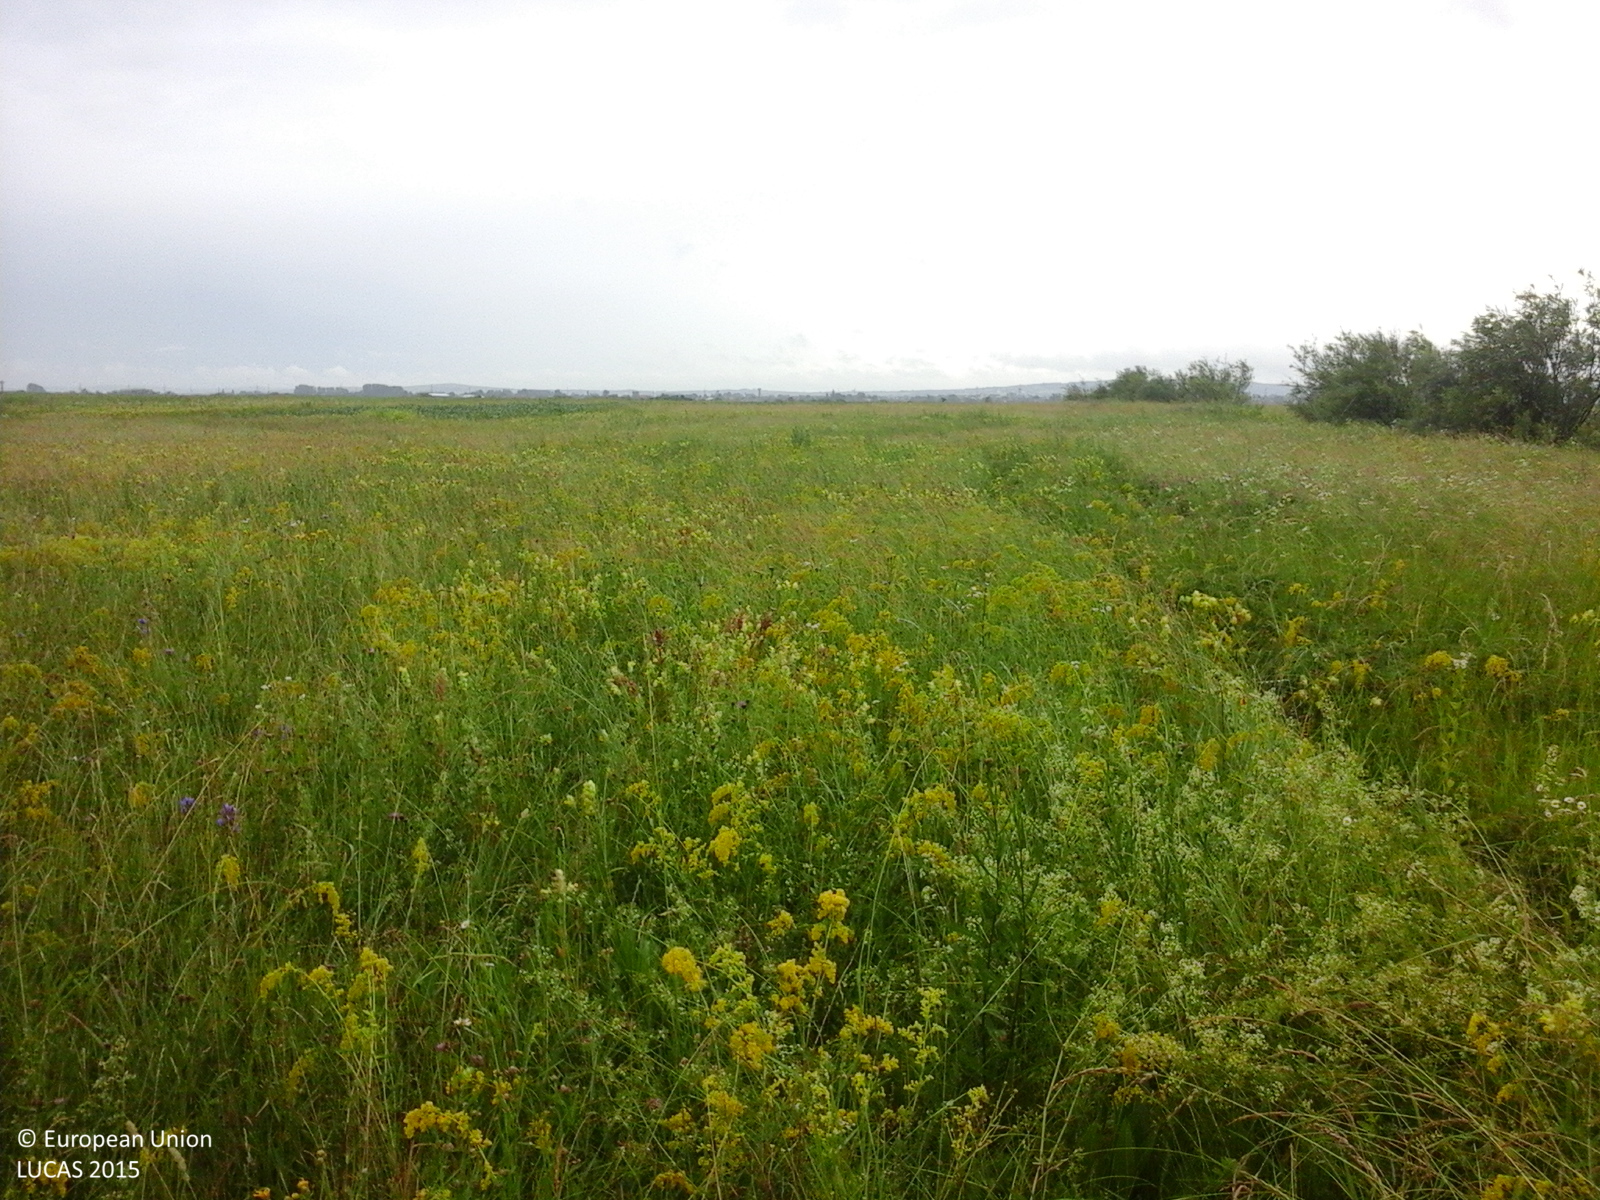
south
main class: Grassland
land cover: Spontaneously vegetated surfaces
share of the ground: > 75 %
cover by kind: herbaceous plants 100 %
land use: Fallow land
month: June
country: RO
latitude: 47.8818
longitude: 25.9218
